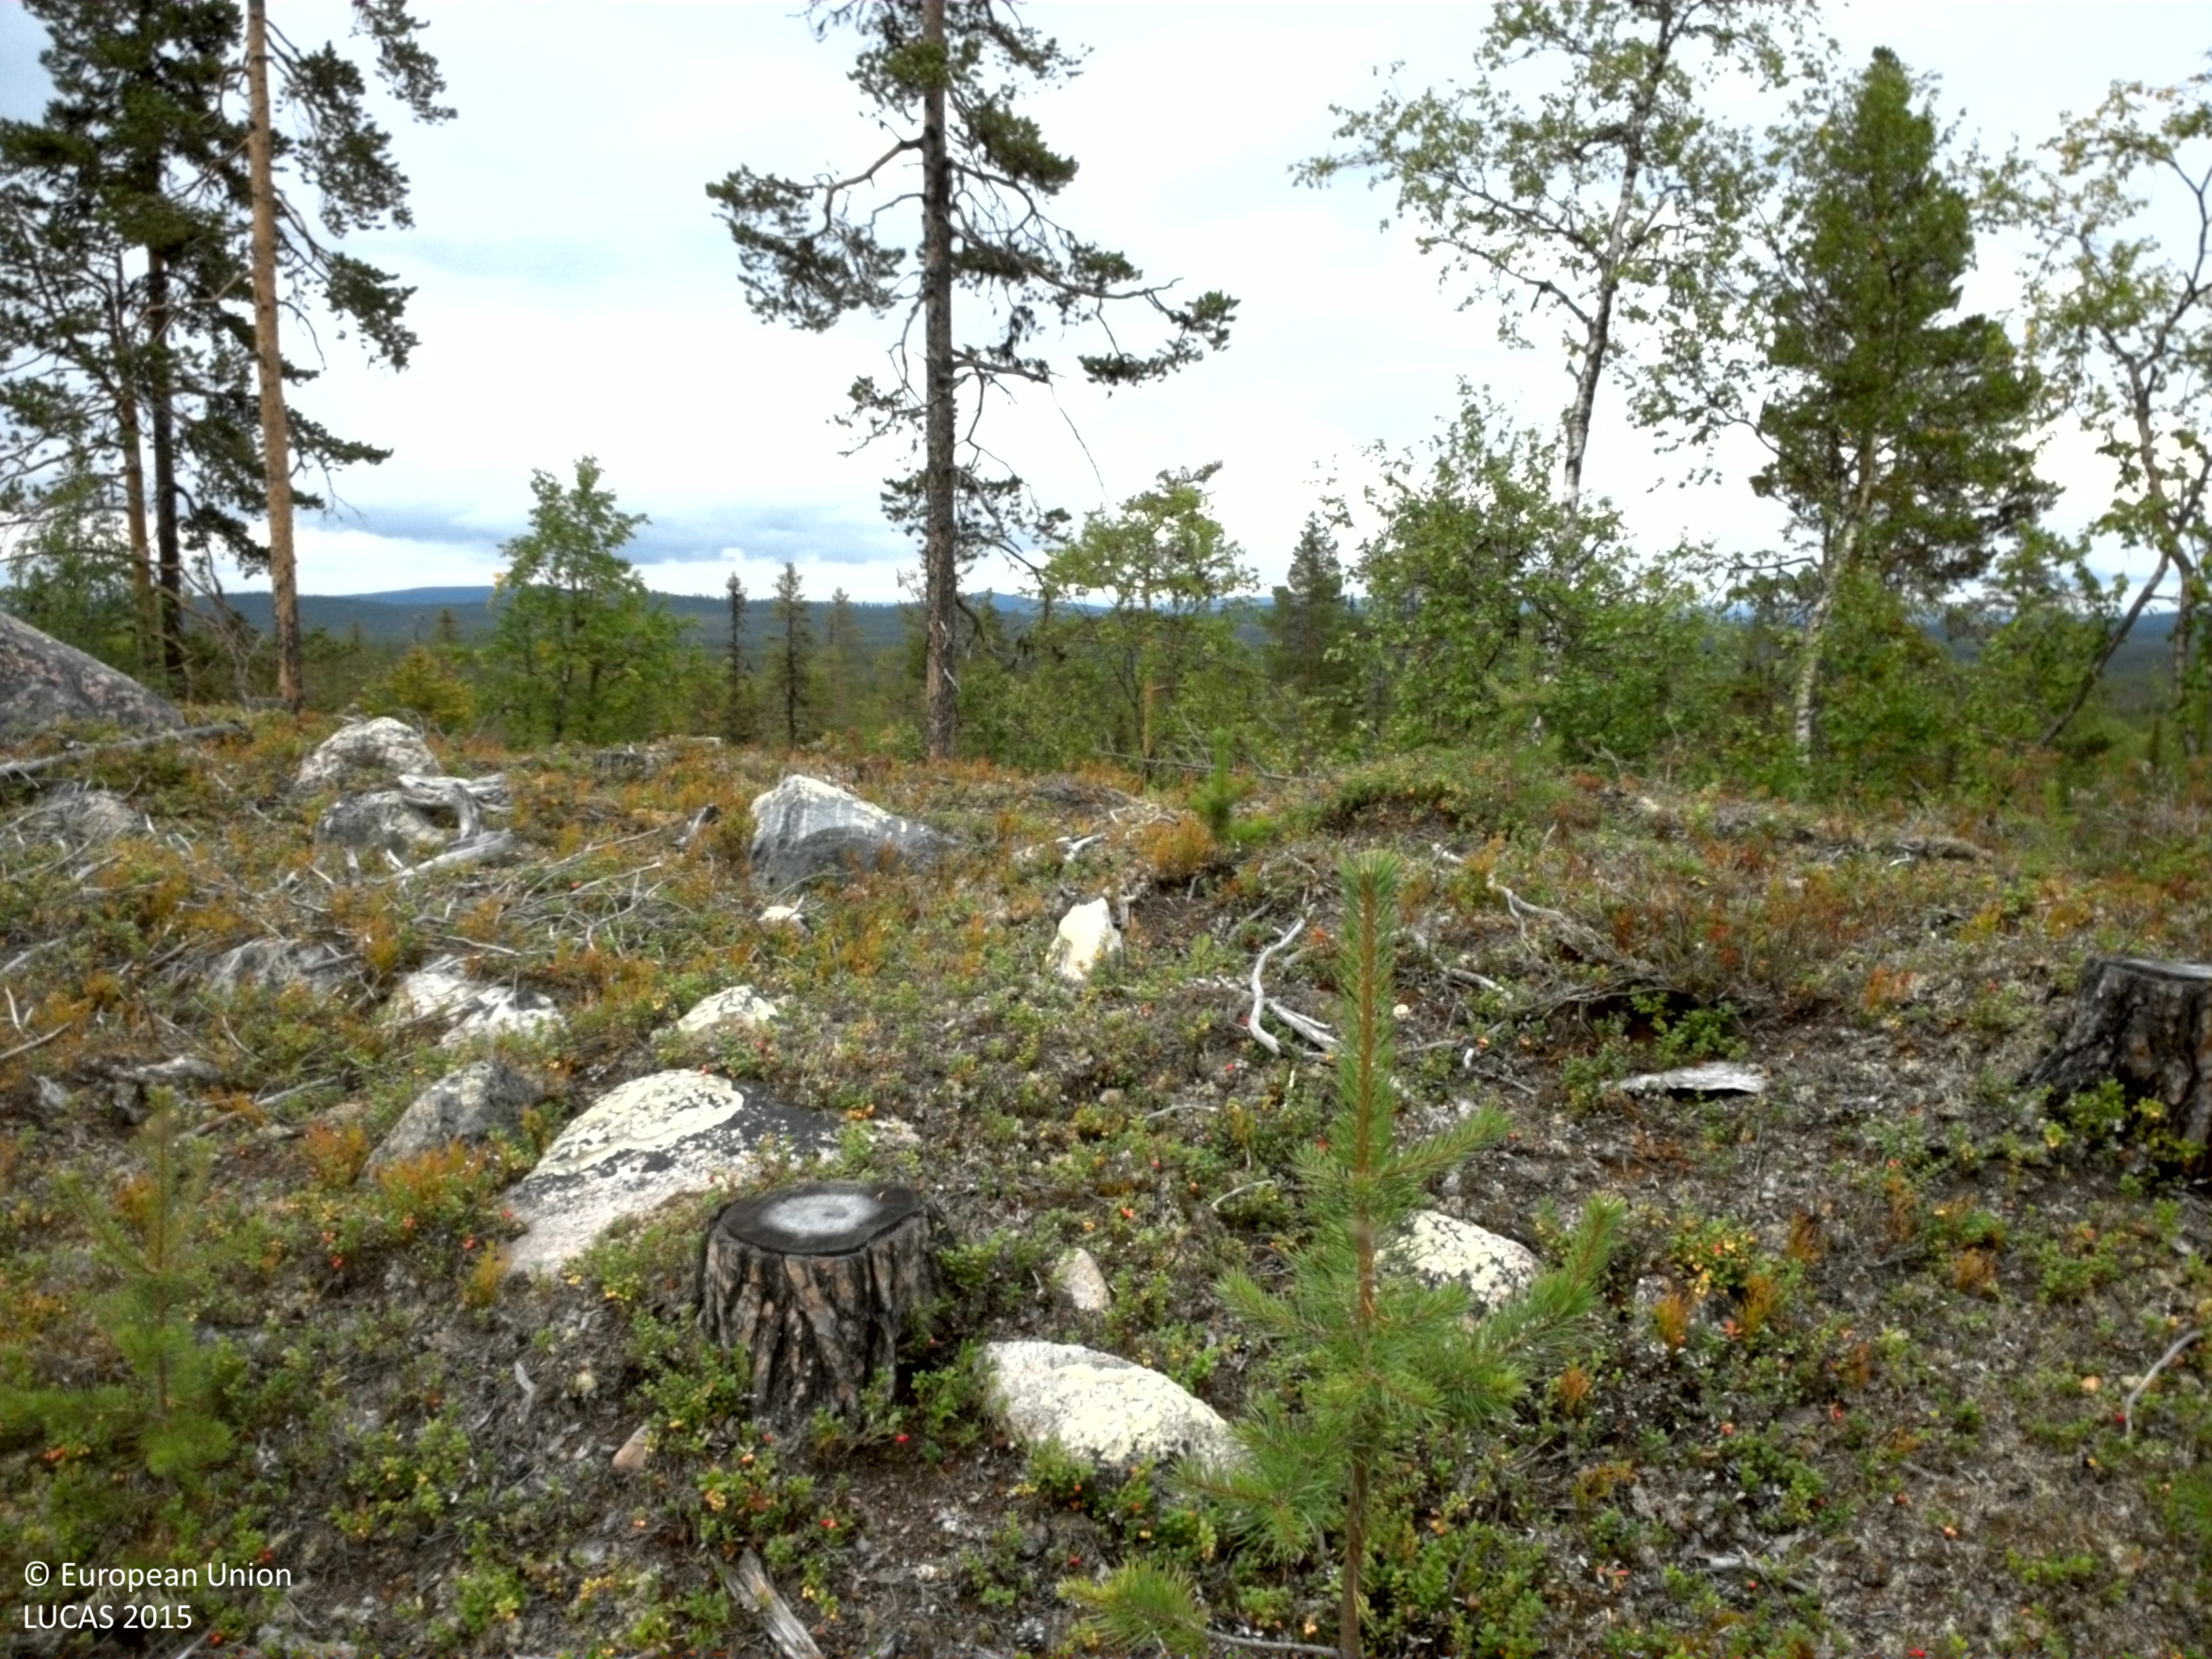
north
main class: Shrubland
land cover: Shrubland with sparse tree cover
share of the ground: > 75 %
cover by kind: shrubs 75 %, lichens and mosses 15 %, broadleaved forest trees 5 %, consolidated bare surface 5 %
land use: Forestry
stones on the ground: 25 - 50 %
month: August
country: SE
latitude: 66.5442
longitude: 19.3851
